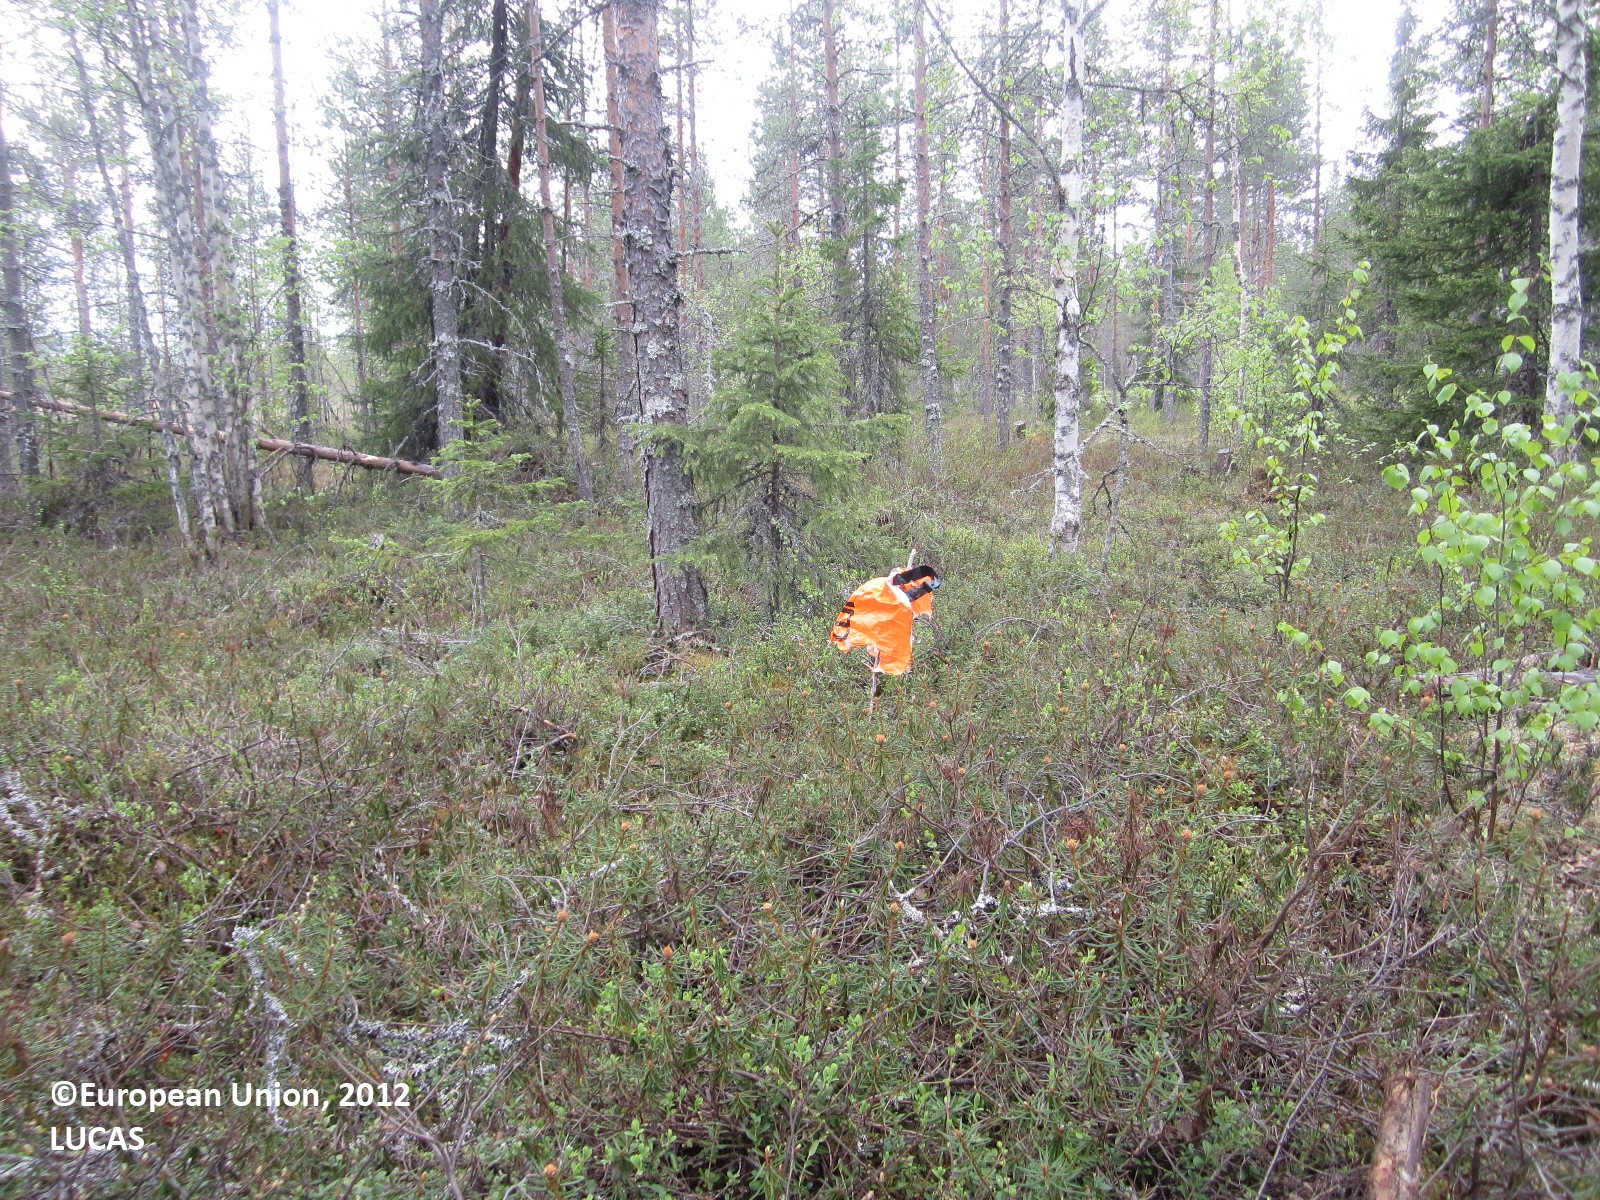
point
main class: Woodland
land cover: Pine dominated mixed woodland
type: boreal forest
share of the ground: > 75 %
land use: Forestry
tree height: > 5 m
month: June
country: FI
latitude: 64.7996
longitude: 28.7241
